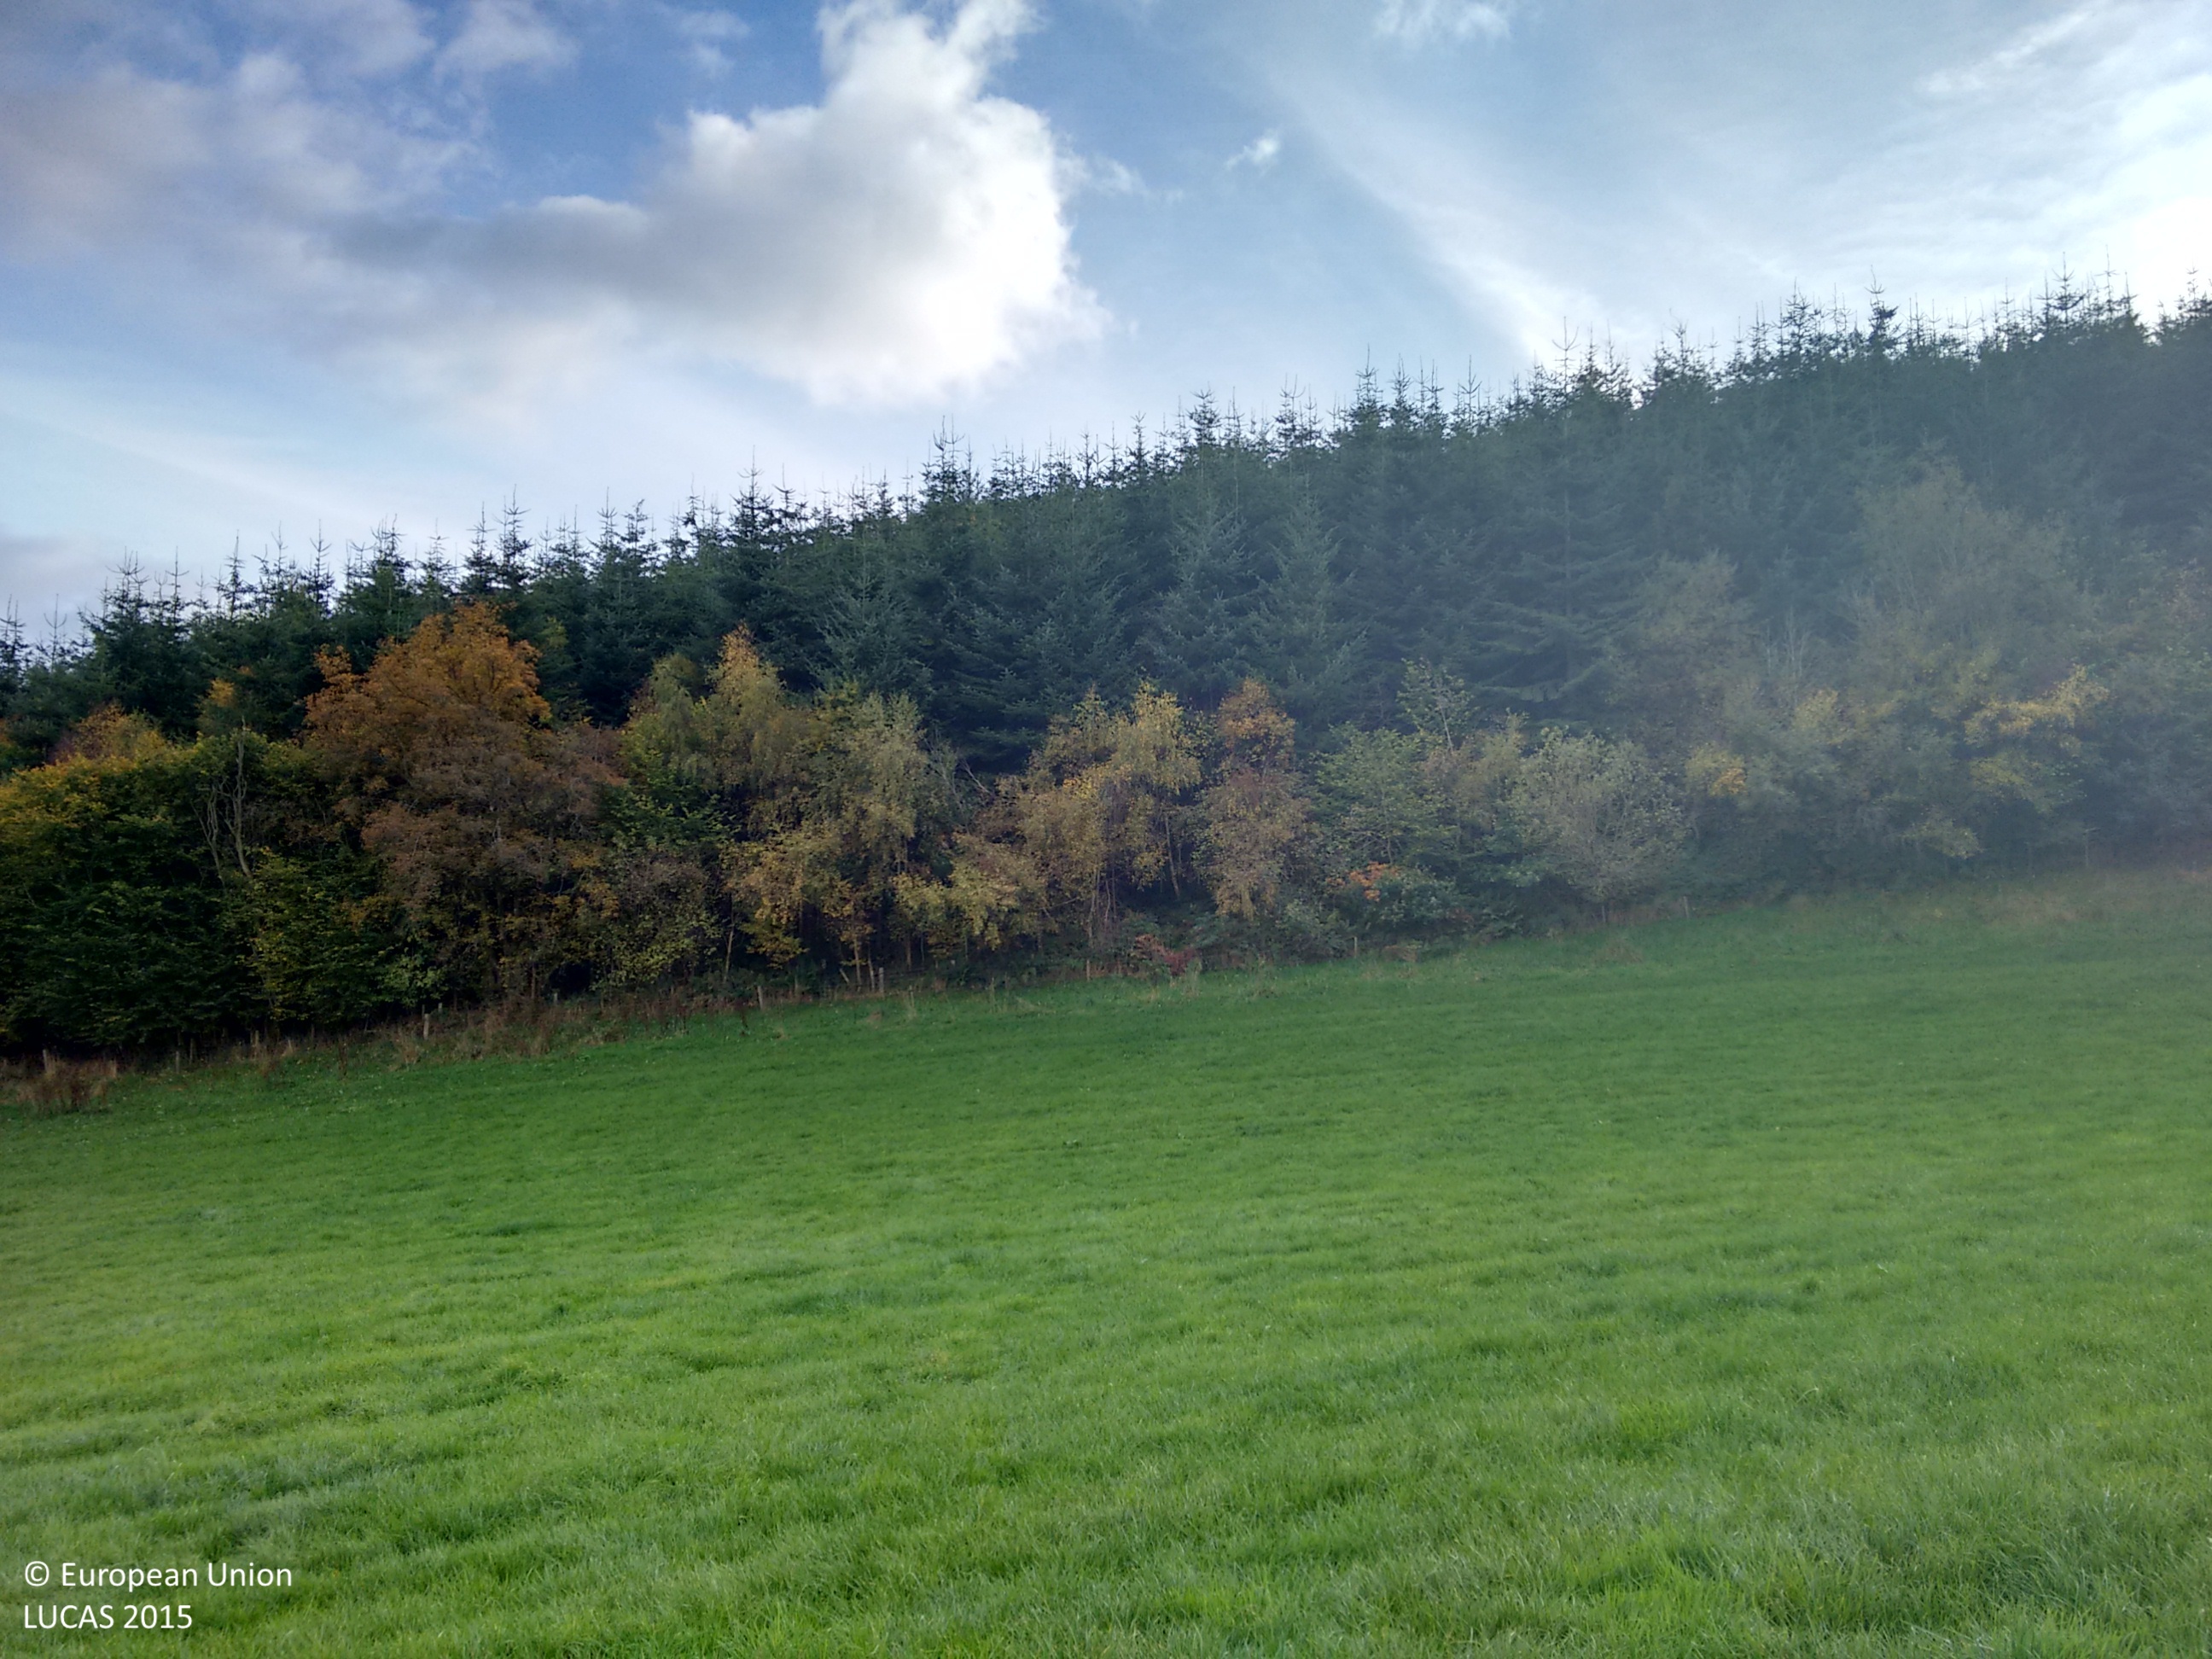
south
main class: Grassland
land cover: Grassland without tree/shrub cover
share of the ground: > 75 %
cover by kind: herbaceous plants 100 %
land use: Agriculture (excluding fallow land and kitchen gardens)
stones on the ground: < 10 %
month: October
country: GB
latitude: 52.2410
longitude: -3.0065
